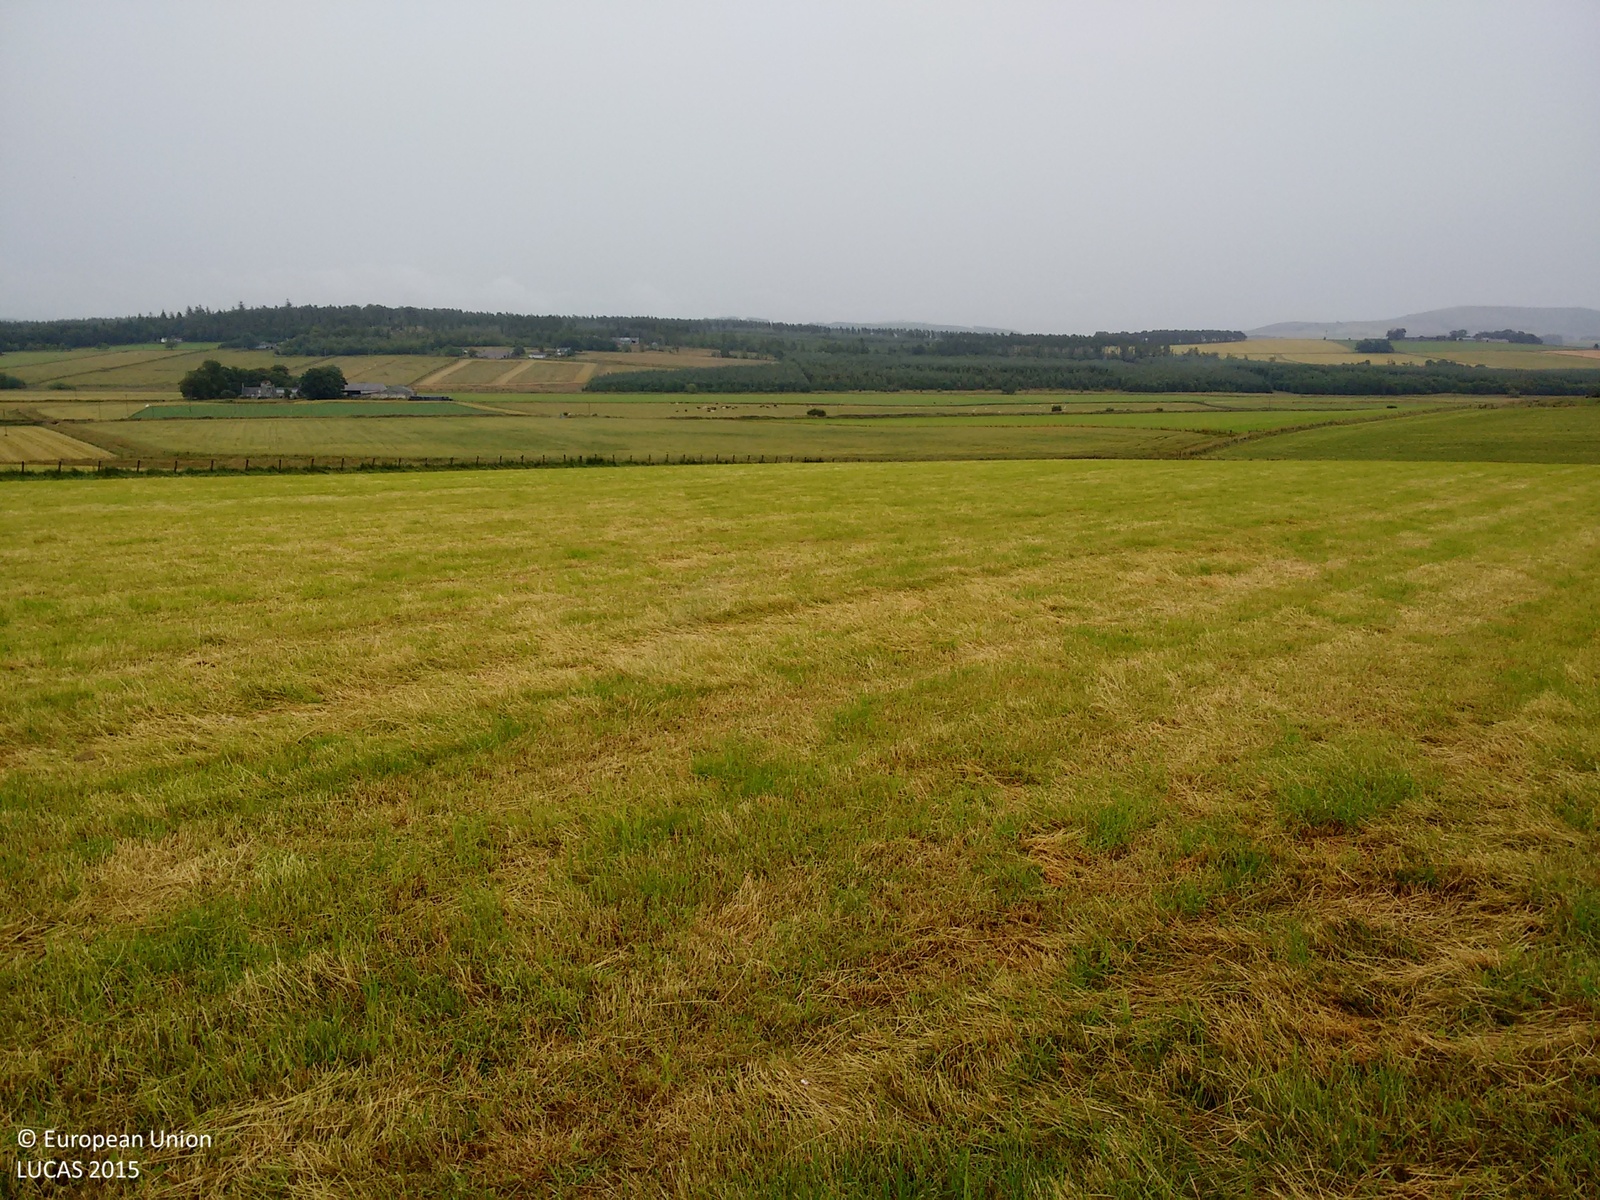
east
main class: Cropland
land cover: Temporary grasslands
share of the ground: > 75 %
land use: Agriculture (excluding fallow land and kitchen gardens)
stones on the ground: < 10 %
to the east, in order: Temporary grasslands; Fences; Temporary grasslands; Fences; Grass margins; Ditches and canals; Grass margins; Fences; Grass margins; Barley
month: August
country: GB
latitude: 57.5279
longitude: -2.8336
